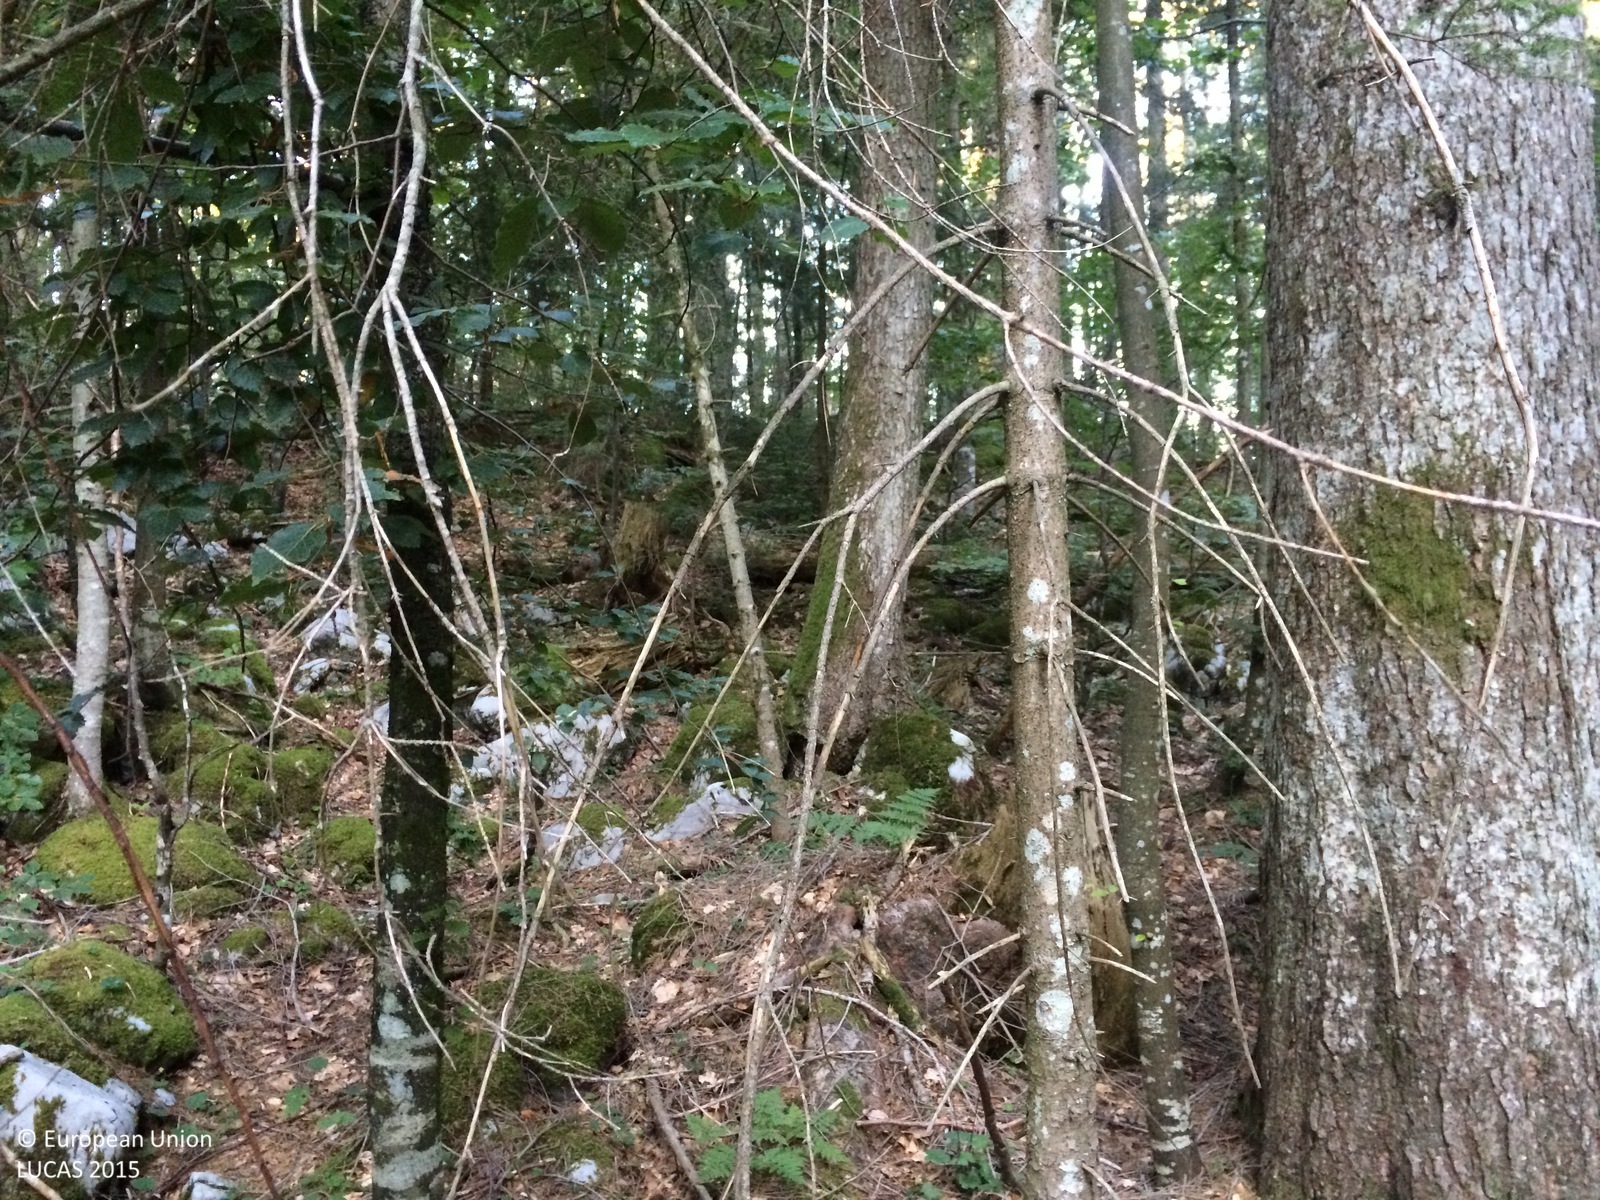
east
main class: Woodland
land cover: Other mixed woodland
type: mountainous beech forest
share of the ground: > 75 %
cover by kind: broadleaved forest trees 75 %, coniferous forest trees 25 %
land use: Forestry
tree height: > 5 m
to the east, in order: Other mixed woodland
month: September
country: HR
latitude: 45.5668
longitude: 14.5953
